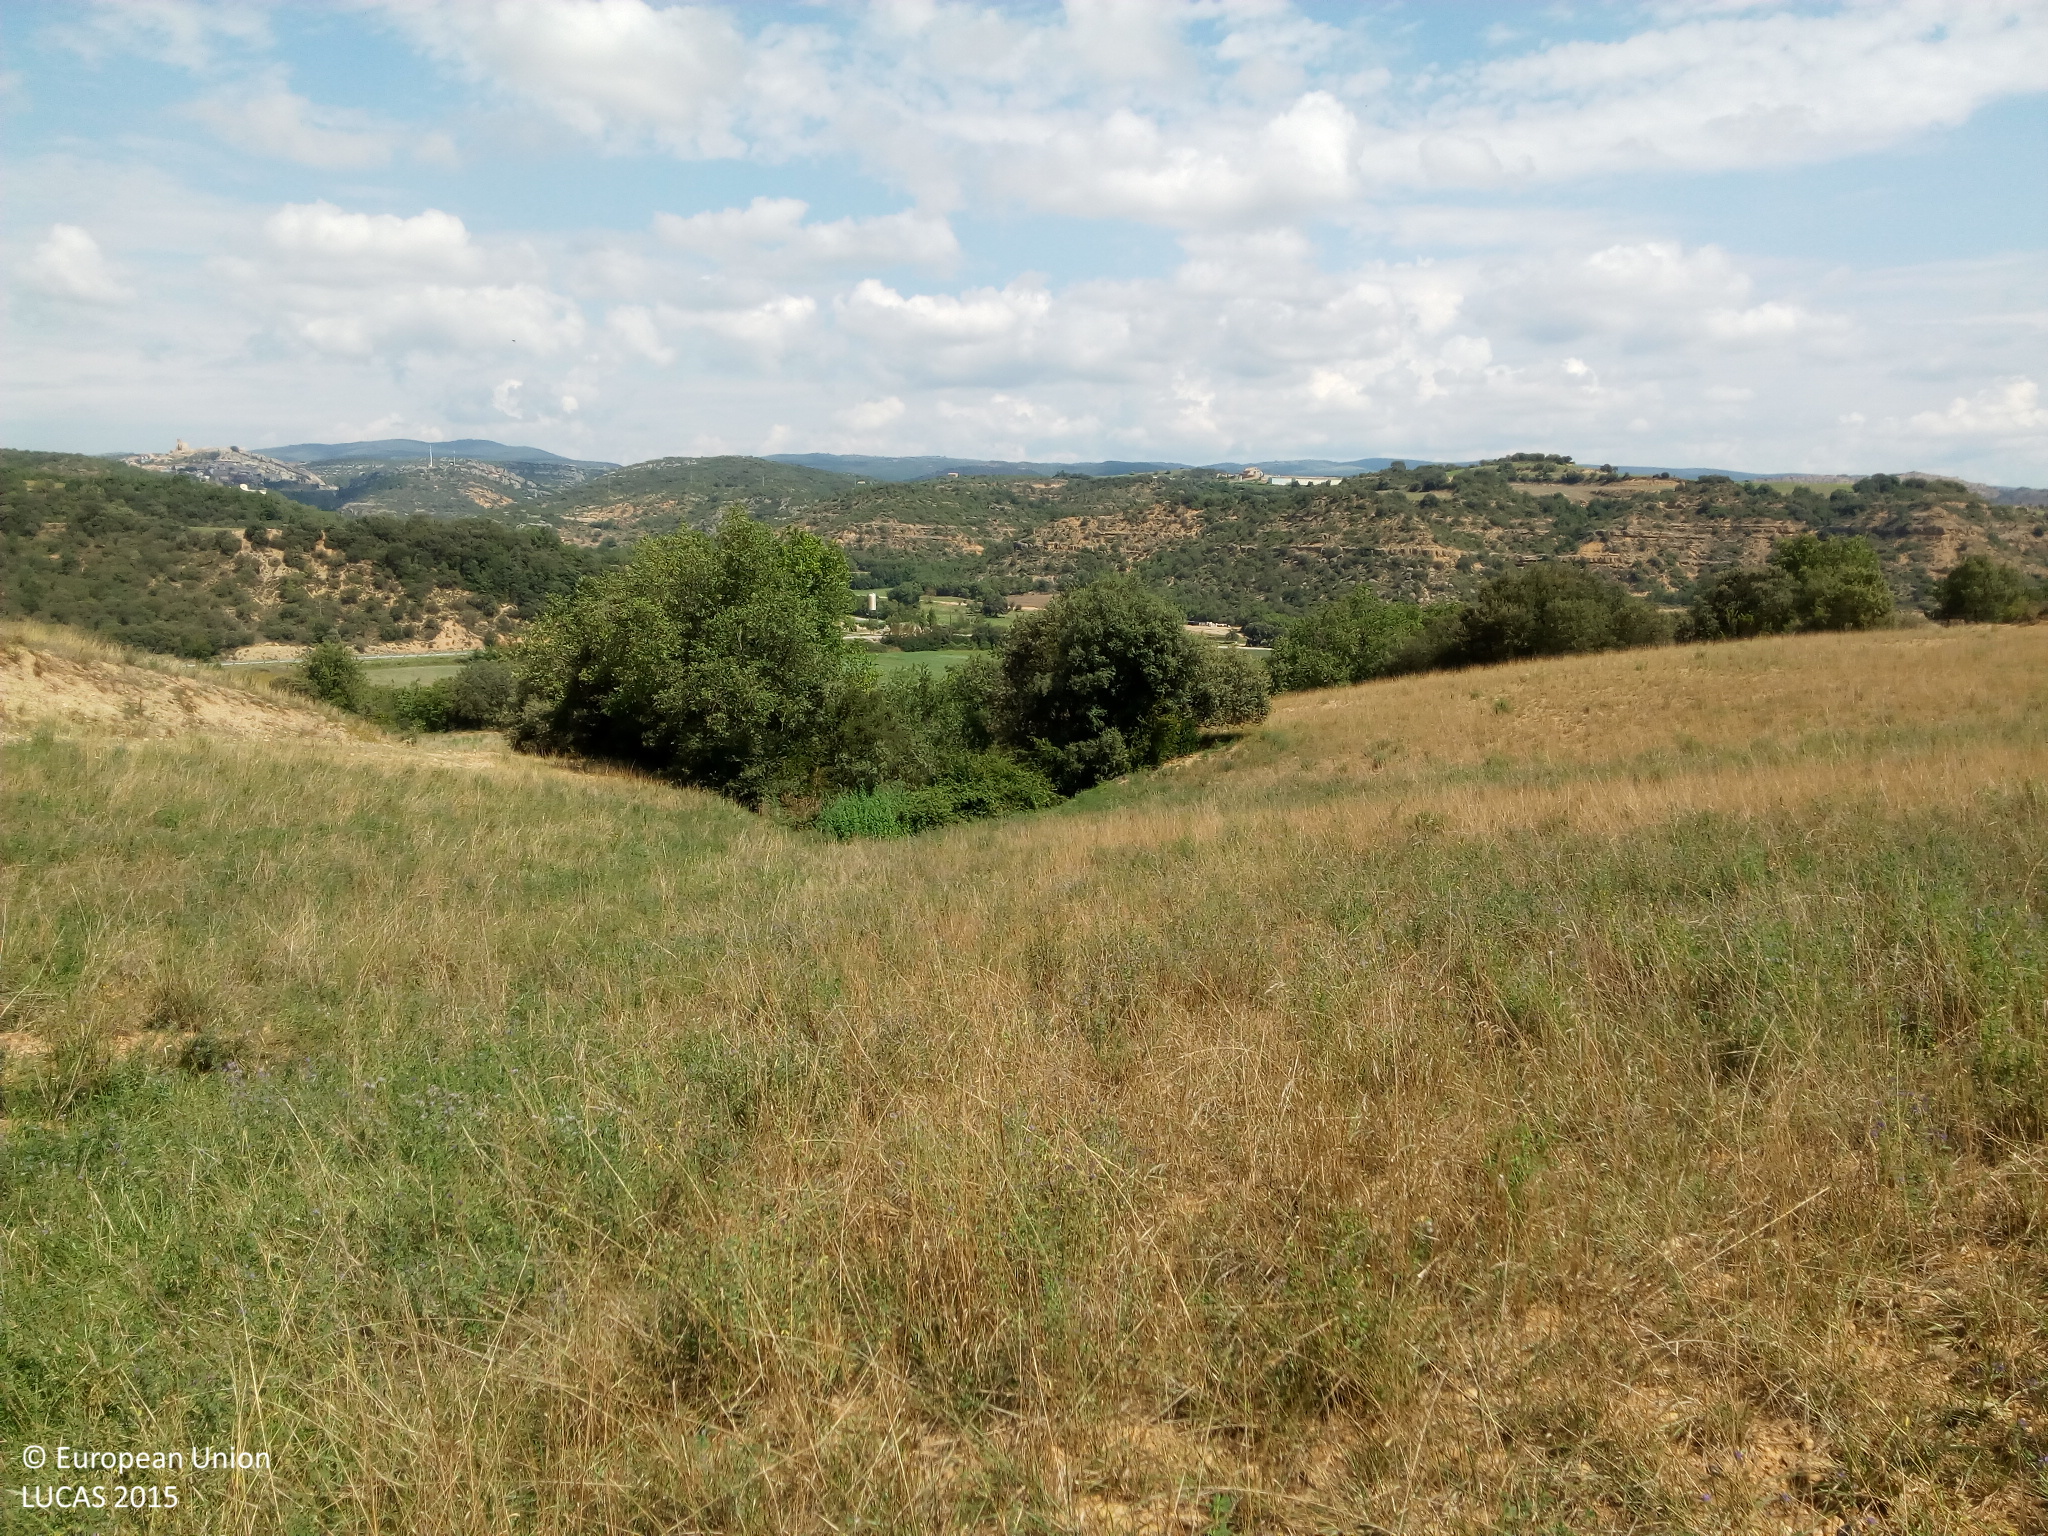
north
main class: Grassland
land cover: Grassland without tree/shrub cover
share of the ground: > 75 %
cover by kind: unconsolidated bare surface 60 %, herbaceous plants 40 %
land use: Agriculture (excluding fallow land and kitchen gardens)
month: August
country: ES
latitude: 42.0789
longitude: 0.4946
